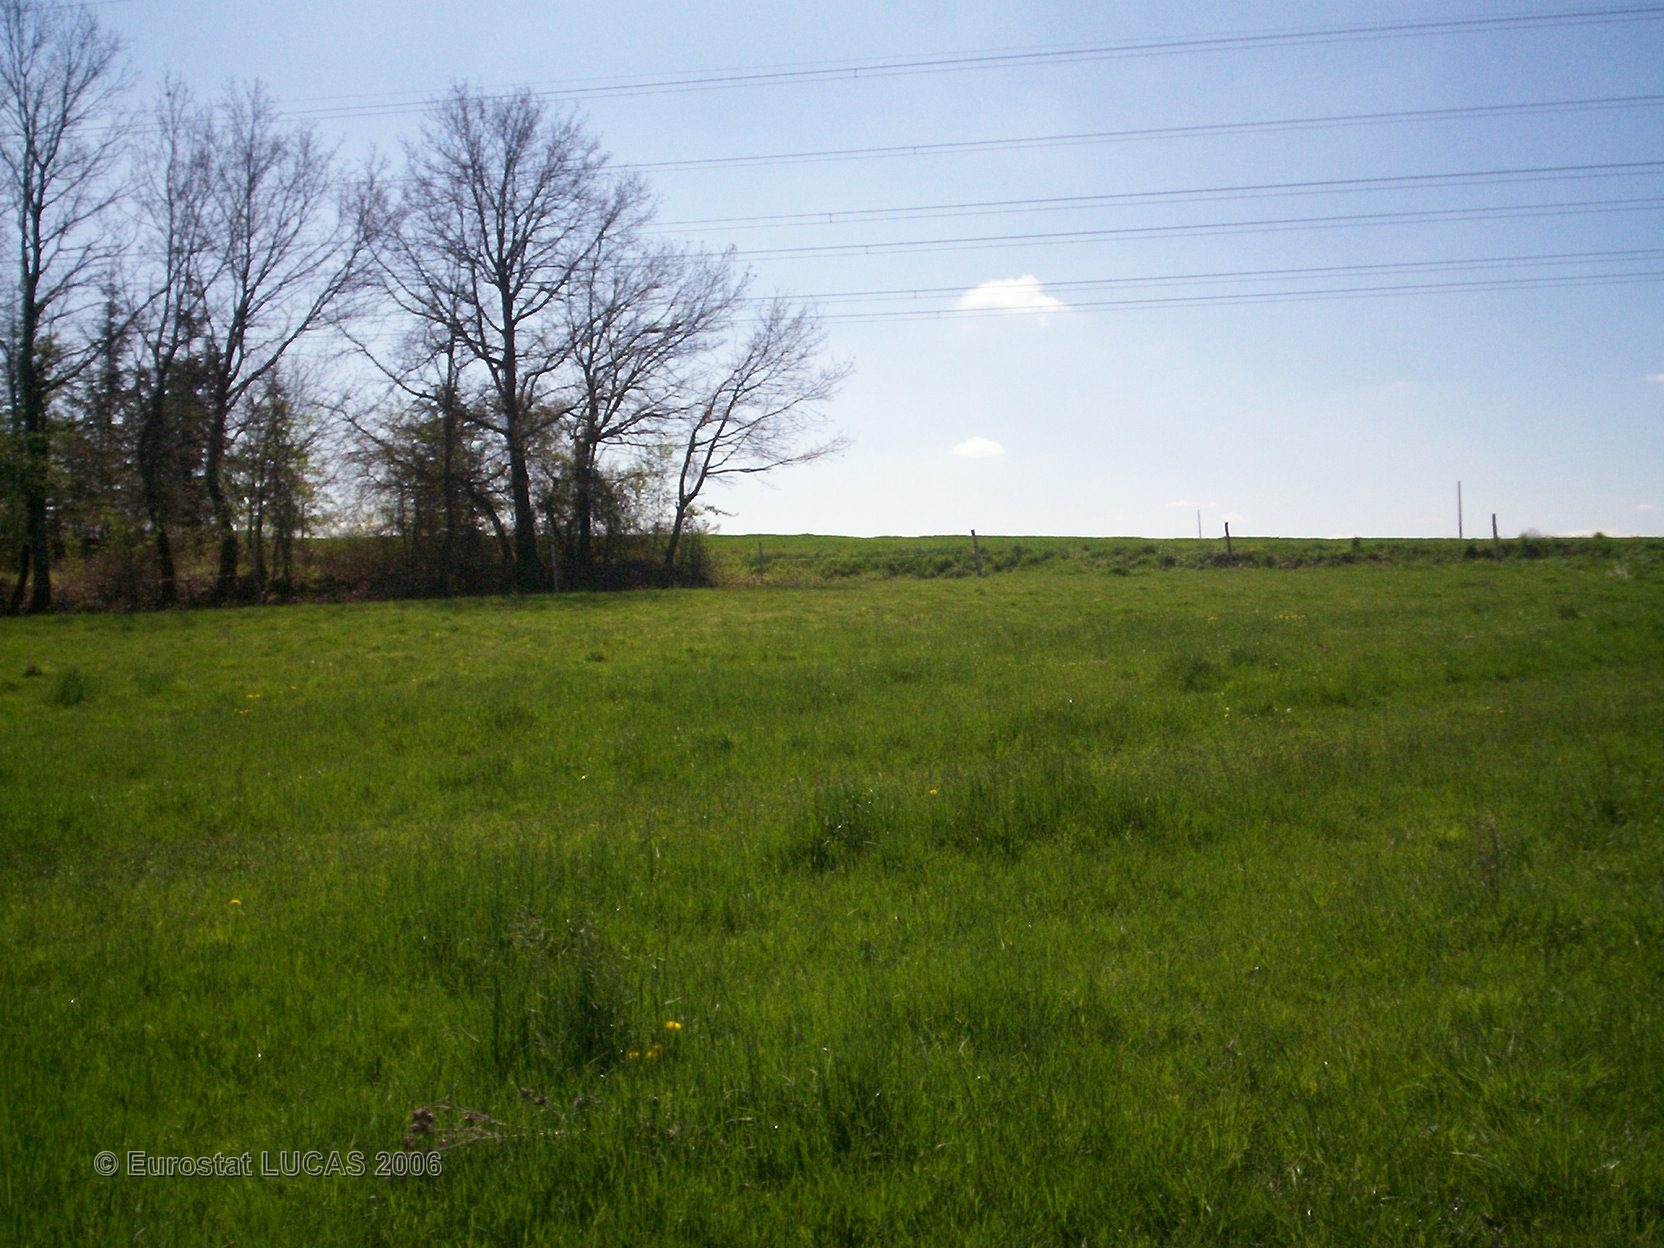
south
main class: Grassland
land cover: Grassland without tree/shrub cover
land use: Agriculture (excluding fallow land and kitchen gardens)
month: April
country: FR
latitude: 44.0228
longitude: 0.9027
